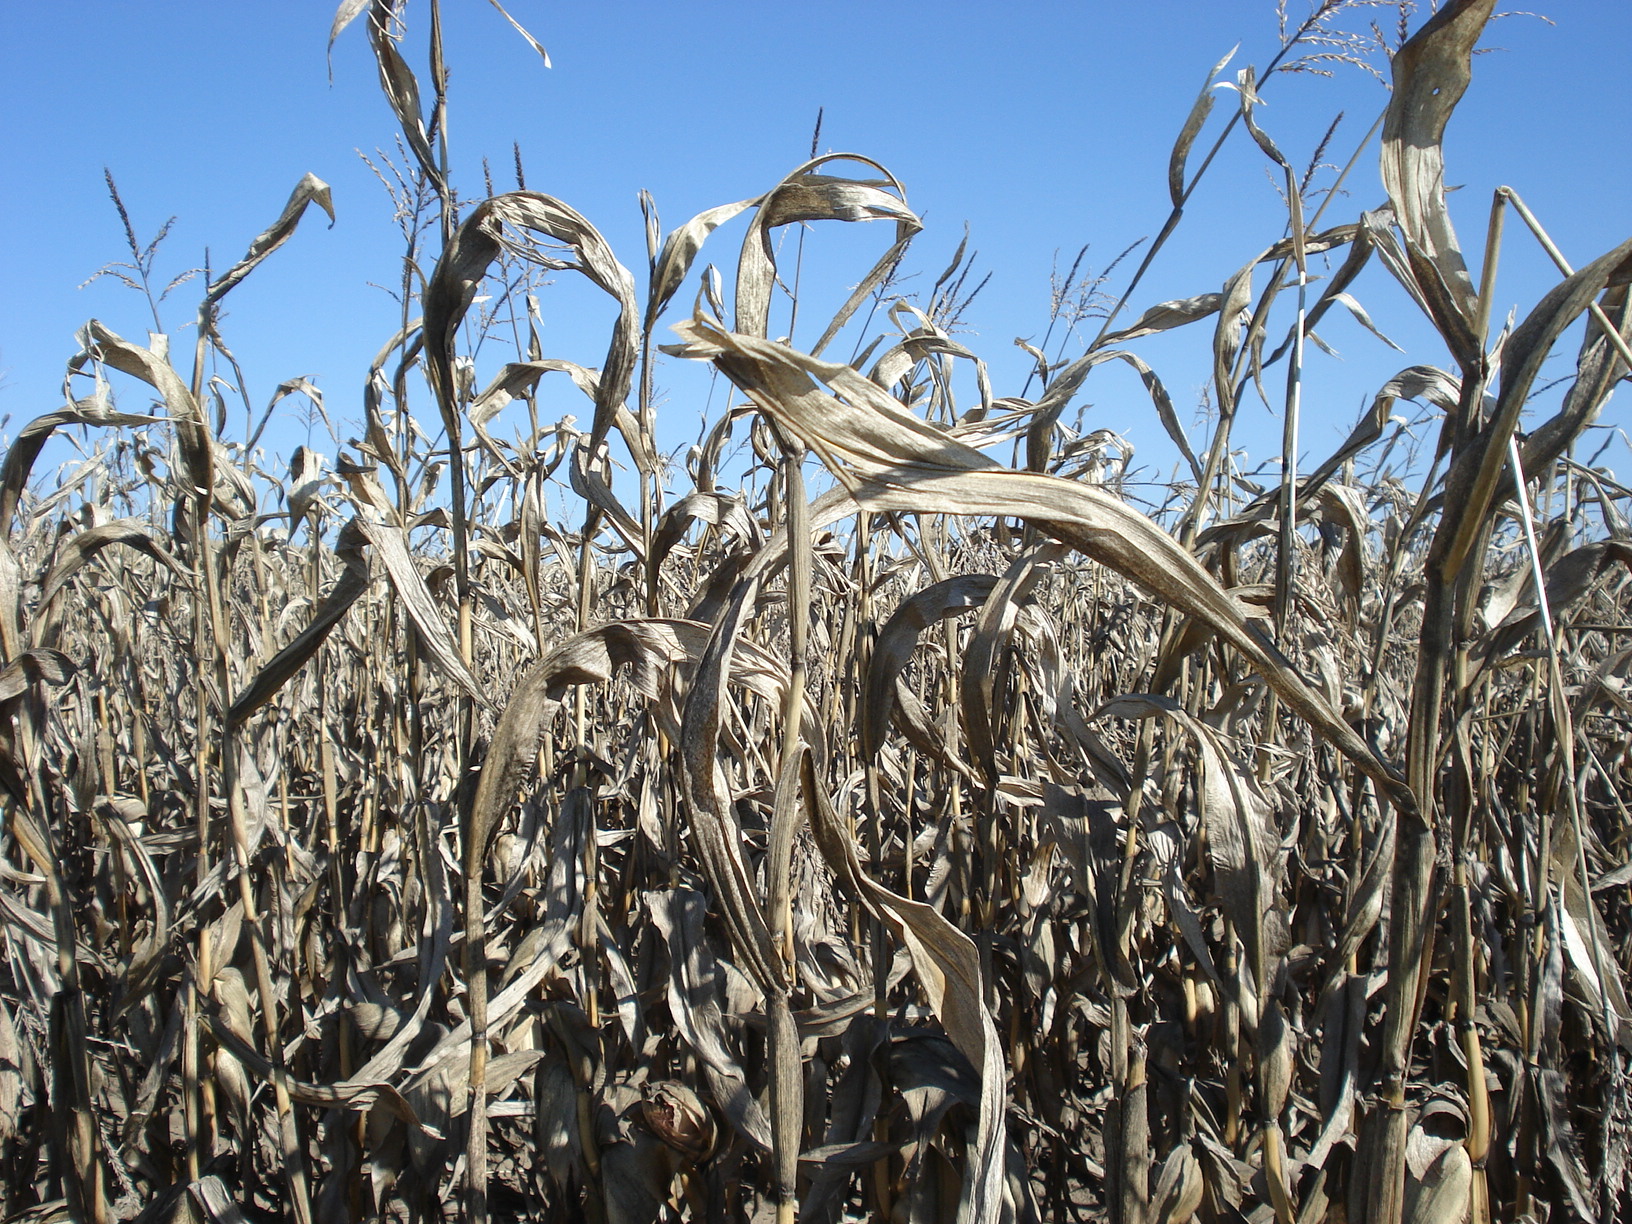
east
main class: Cropland
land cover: Maize
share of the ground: > 75 %
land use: Agriculture (excluding fallow land and kitchen gardens)
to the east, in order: Maize
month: September
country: BG
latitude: 43.3211
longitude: 25.2792
